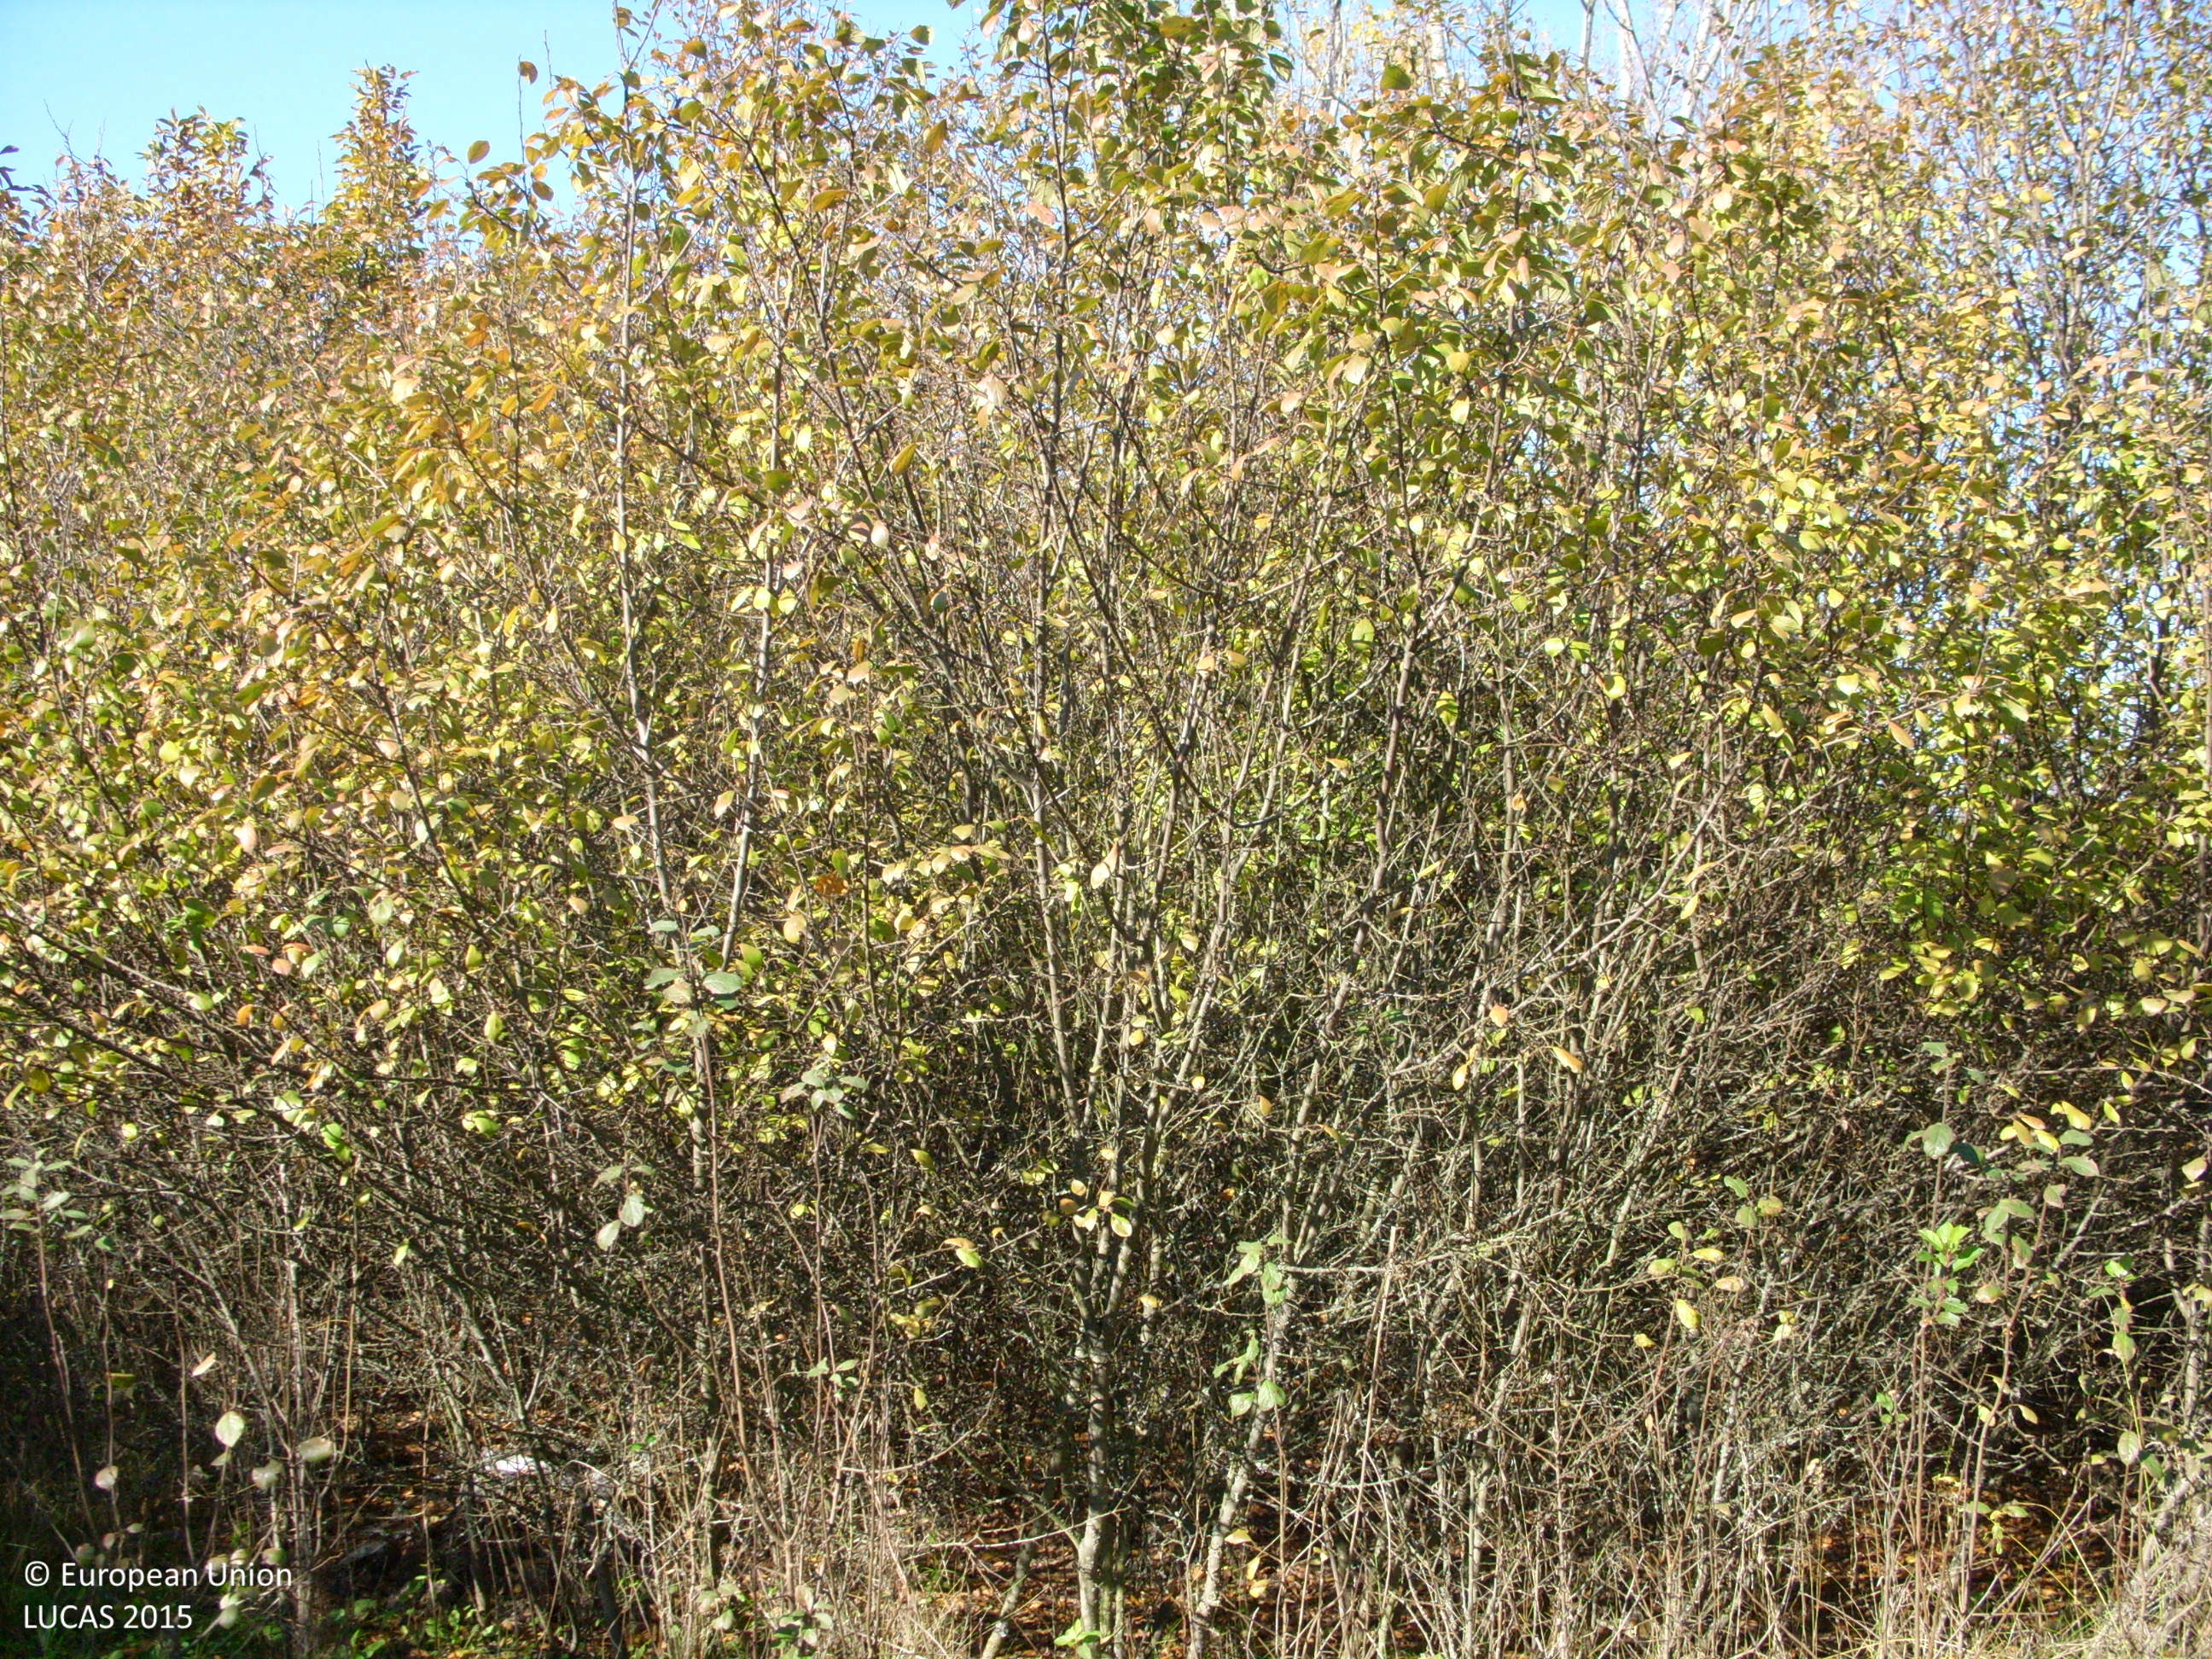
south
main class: Shrubland
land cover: Shrubland with sparse tree cover
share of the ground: > 75 %
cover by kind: shrubs 80 %, herbaceous plants 15 %, broadleaved forest trees 5 %
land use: Abandoned areas
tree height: < 5 m
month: November
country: BG
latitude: 42.3226
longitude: 24.9706
